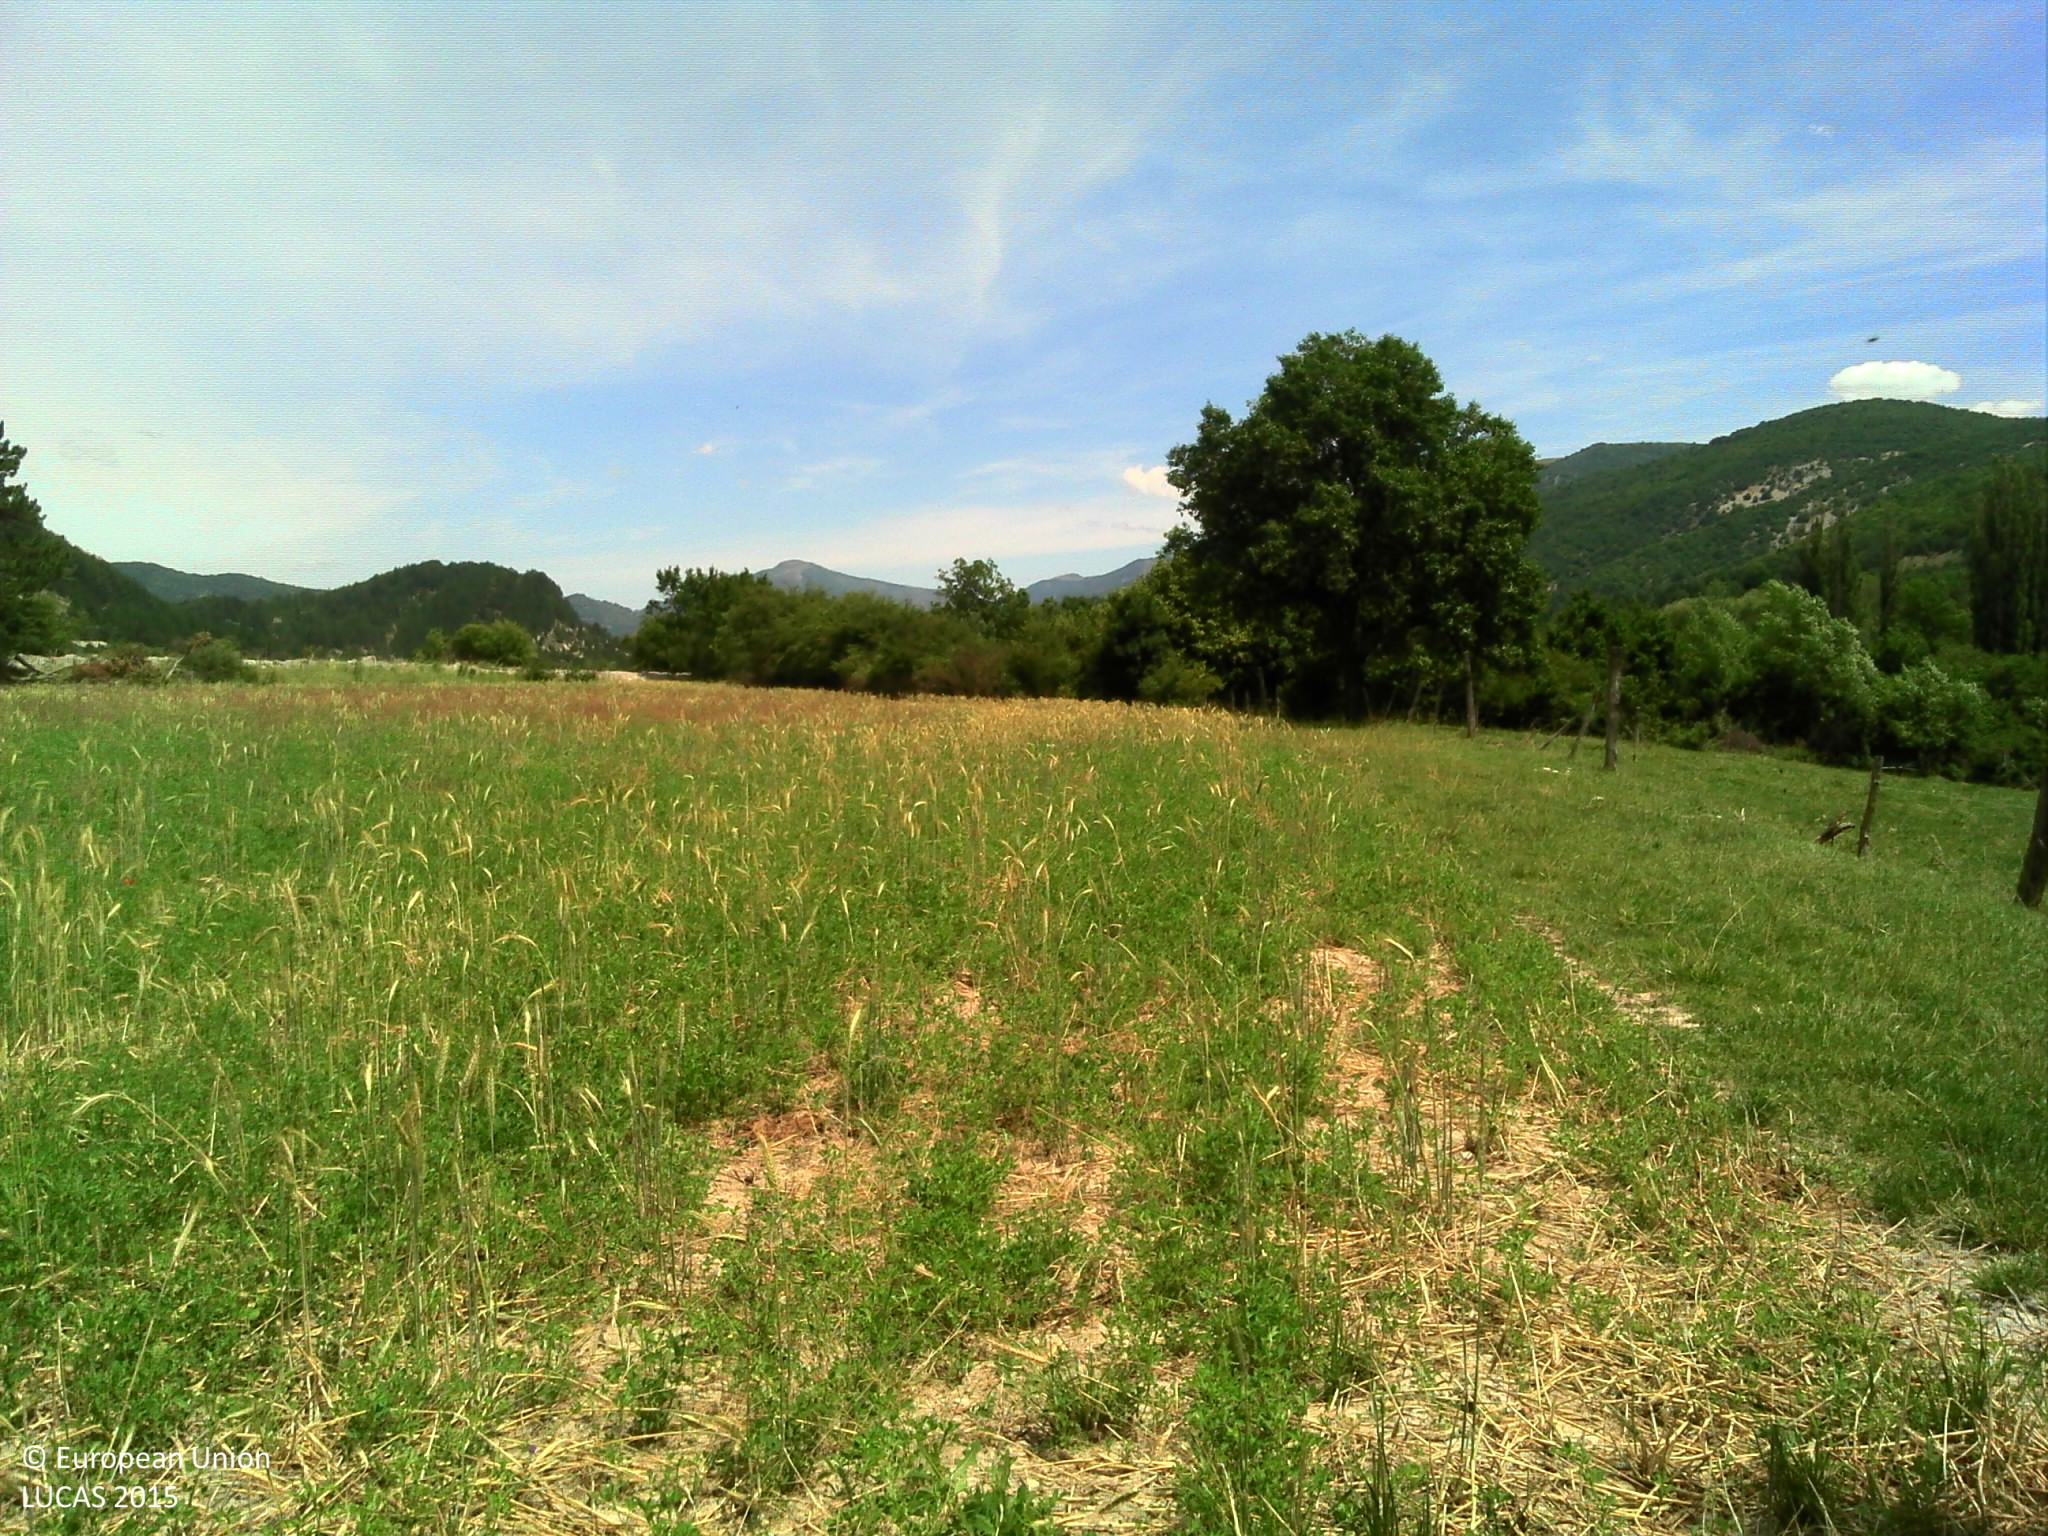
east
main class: Cropland
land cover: Mixed cereals for fodder
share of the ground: > 75 %
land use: Agriculture (excluding fallow land and kitchen gardens)
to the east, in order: Mixed cereals for fodder; Broadleaved woodland; Rivers and streams; Broadleaved woodland; Barley
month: June
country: FR
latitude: 44.2196
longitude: 5.5641
